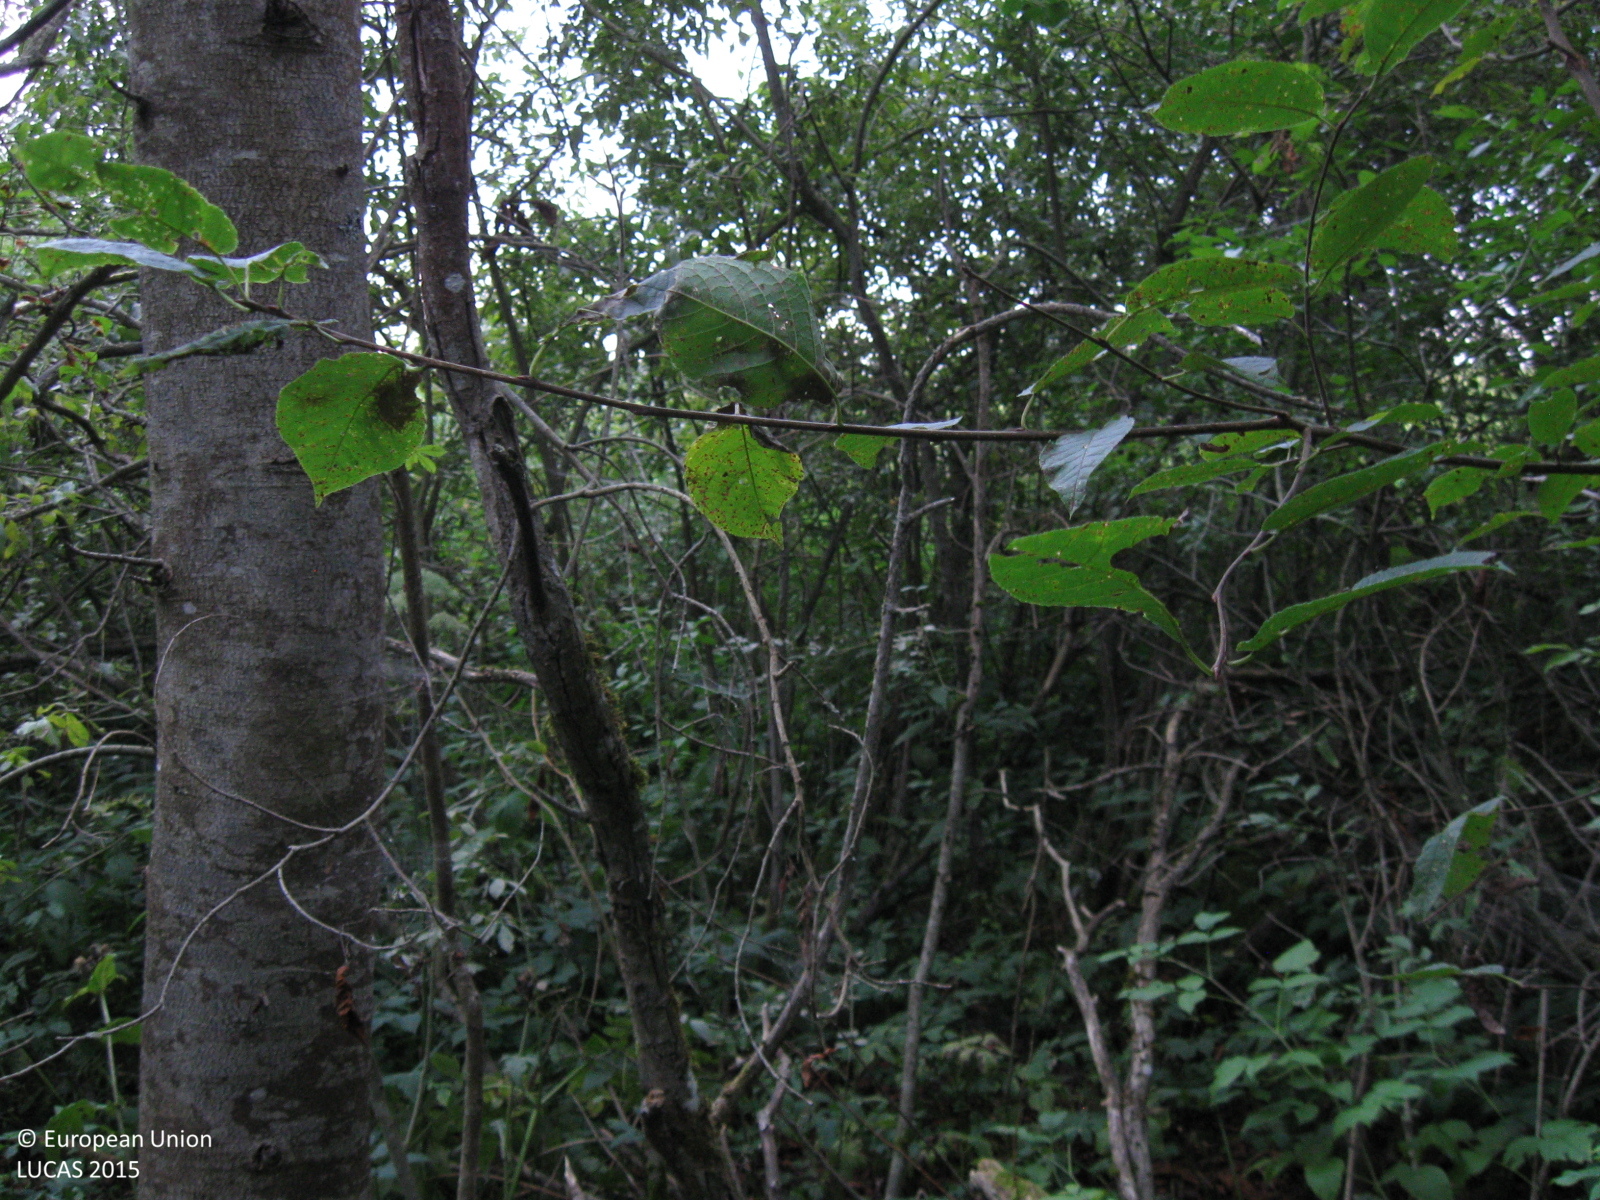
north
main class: Woodland
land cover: Broadleaved woodland
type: non-riverine alder, birch or aspen forest
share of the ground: > 75 %
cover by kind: broadleaved forest trees 90 %, coniferous forest trees 5 %, herbaceous plants 5 %
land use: Forestry
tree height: > 5 m
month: August
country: LT
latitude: 55.5418
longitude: 23.3402
